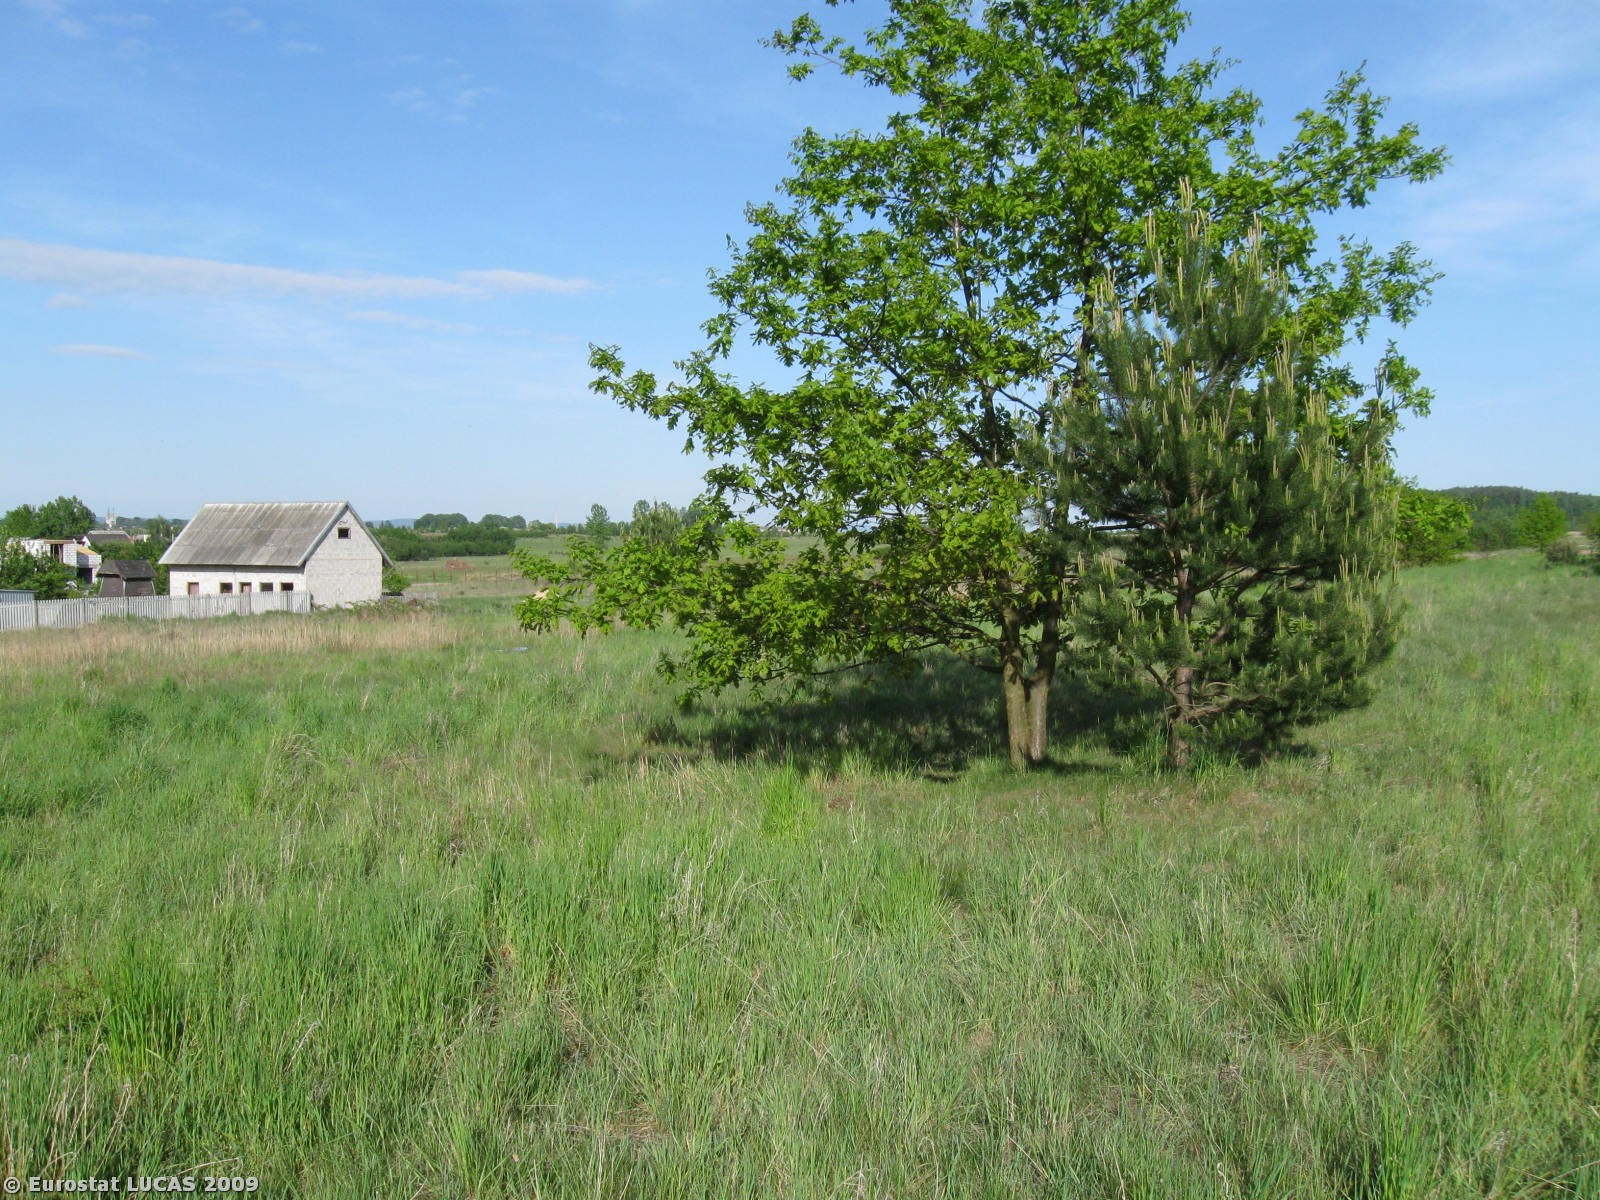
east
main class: Grassland
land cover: Grassland with sparse tree/shrub cover
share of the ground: > 75 %
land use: Unused
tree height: < 5 m
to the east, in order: Grassland with sparse tree/shrub cover; Grassland without tree/shrub cover; Tracks; Grassland without tree/shrub cover
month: May
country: PL
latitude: 50.8656
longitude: 20.4239
